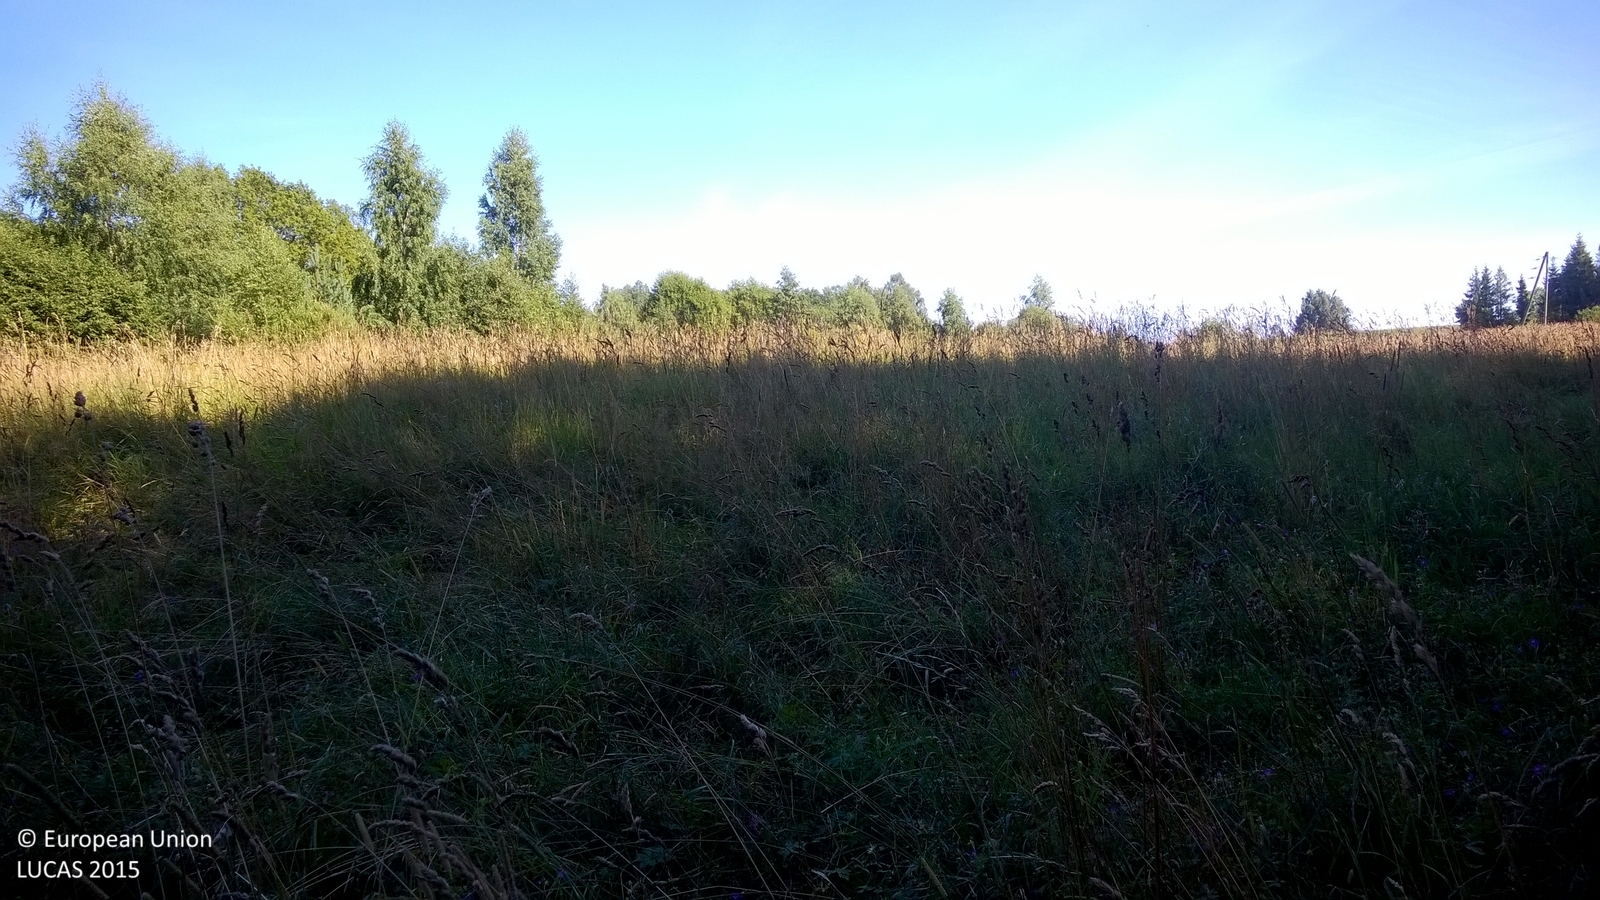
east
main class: Woodland
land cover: Broadleaved woodland
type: non-riverine alder, birch or aspen forest
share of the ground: > 75 %
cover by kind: broadleaved forest trees 90 %, shrubs 5 %, herbaceous plants 5 %
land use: Forestry
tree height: > 5 m
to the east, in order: Broadleaved woodland; Grassland without tree/shrub cover; Abandoned hedges; Paved roads, cycling and walking lanes; Abandoned hedges; Grassland without tree/shrub cover; Broadleaved woodland; Grassland without tree/shrub cover; Broadleaved woodland
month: August
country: LV
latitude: 57.2899
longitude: 25.5309
